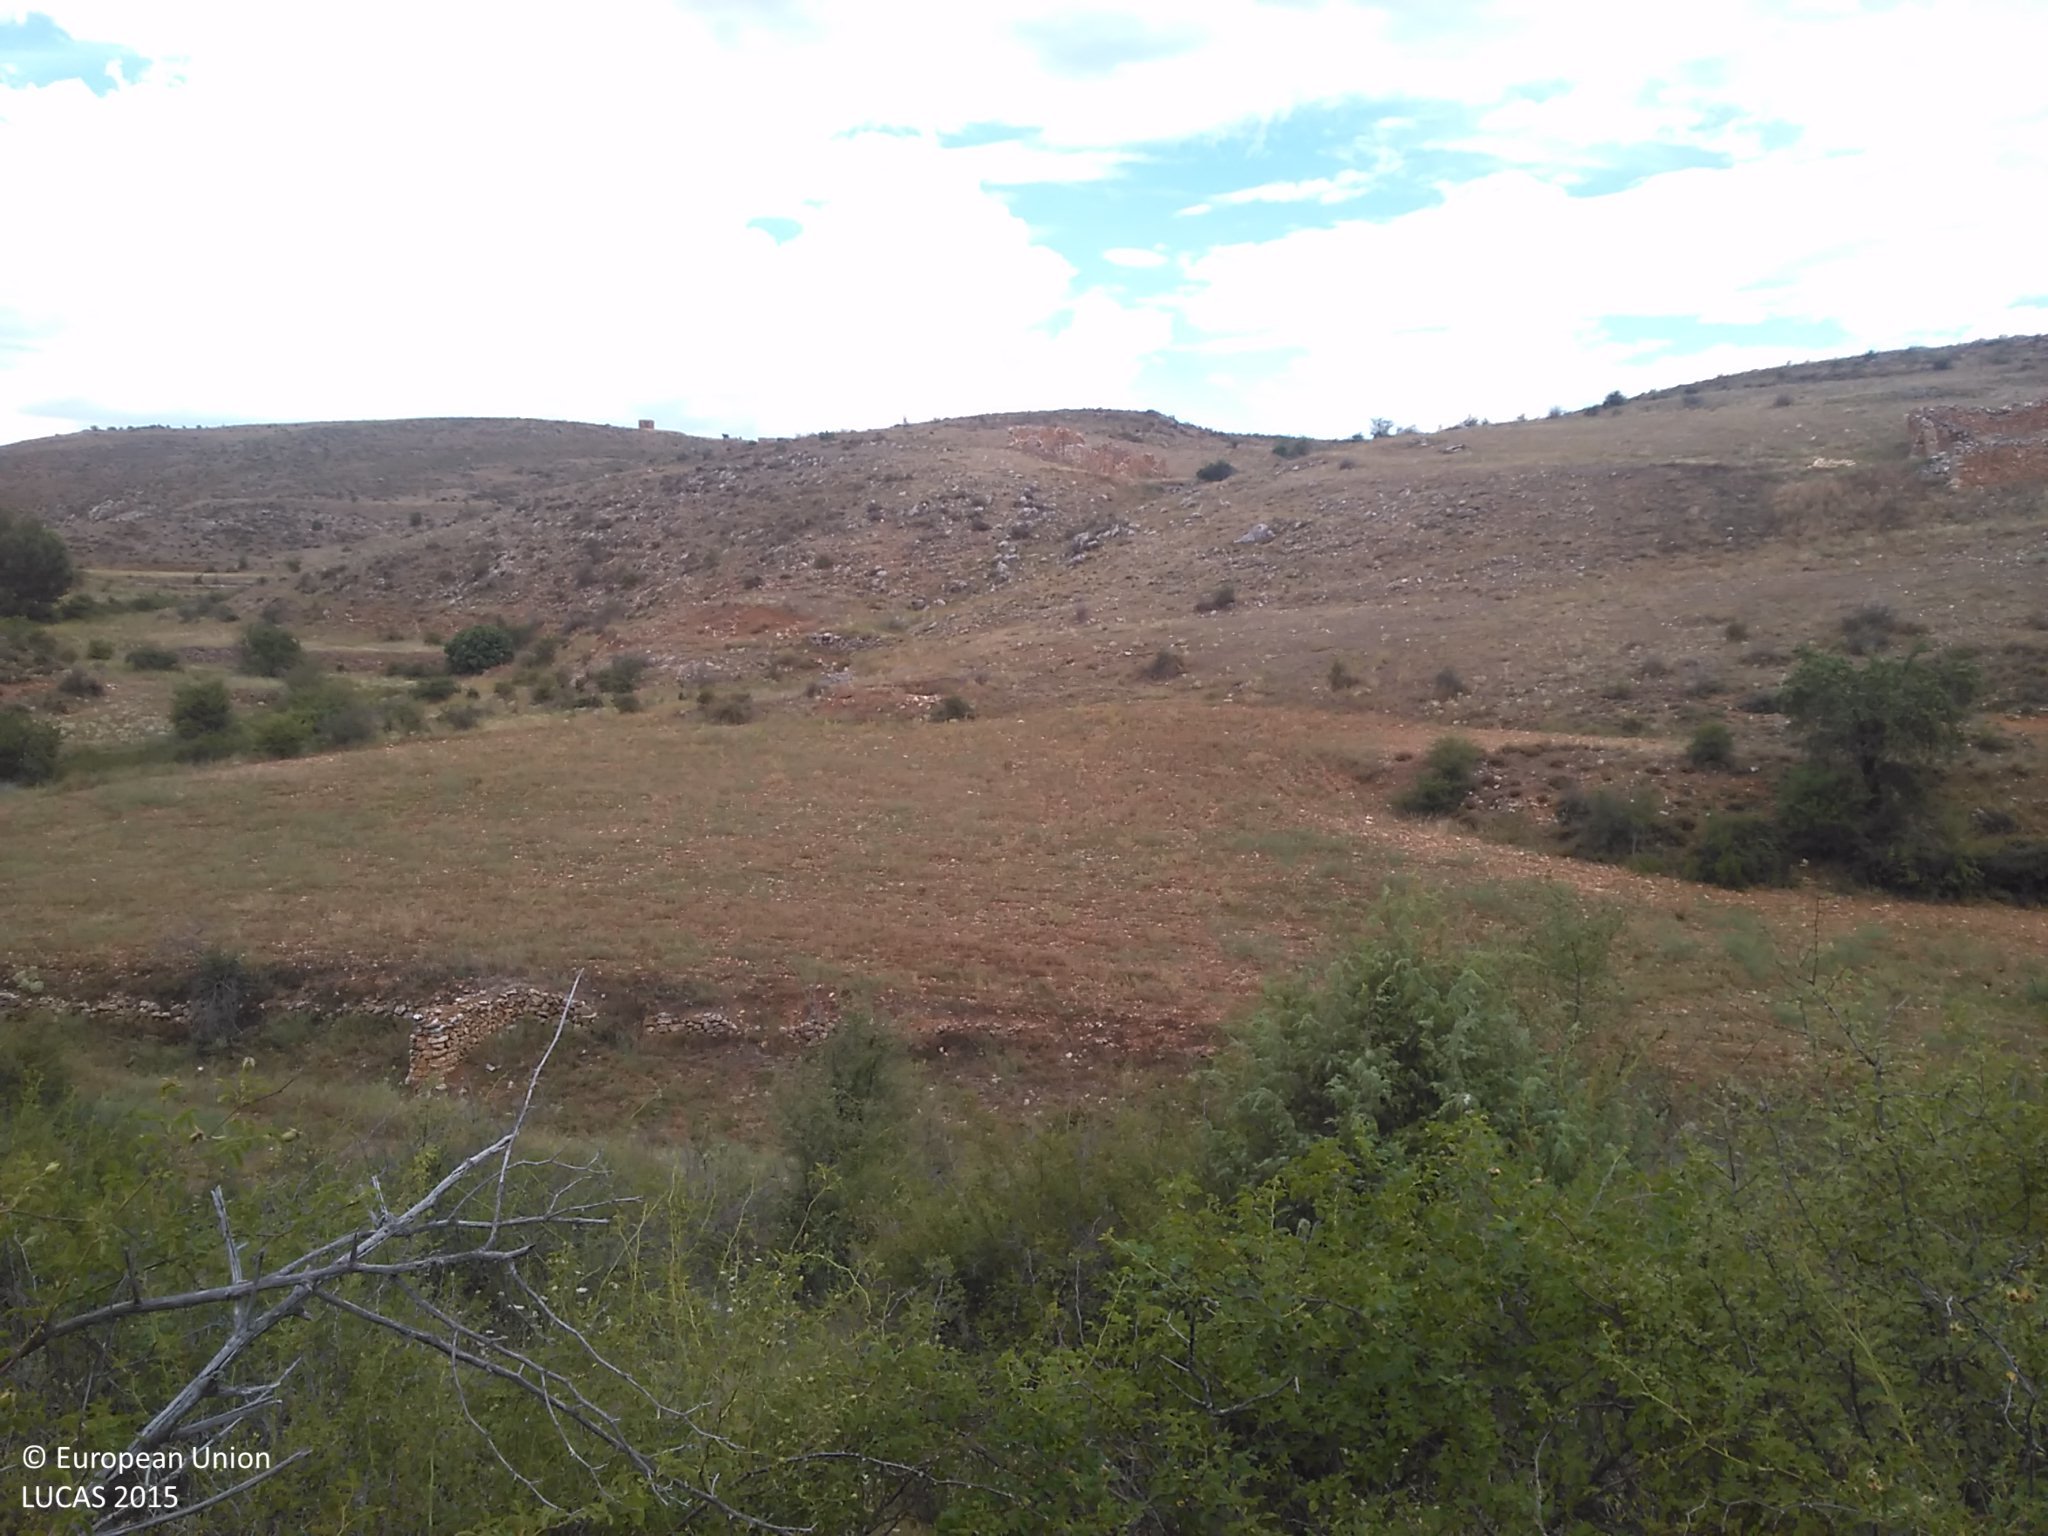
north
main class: Shrubland
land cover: Shrubland without tree cover
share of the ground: 50 - 75 %
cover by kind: shrubs 70 %, herbaceous plants 30 %
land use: Semi-natural and natural areas not in use
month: July
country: ES
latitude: 41.4290
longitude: -1.9837
